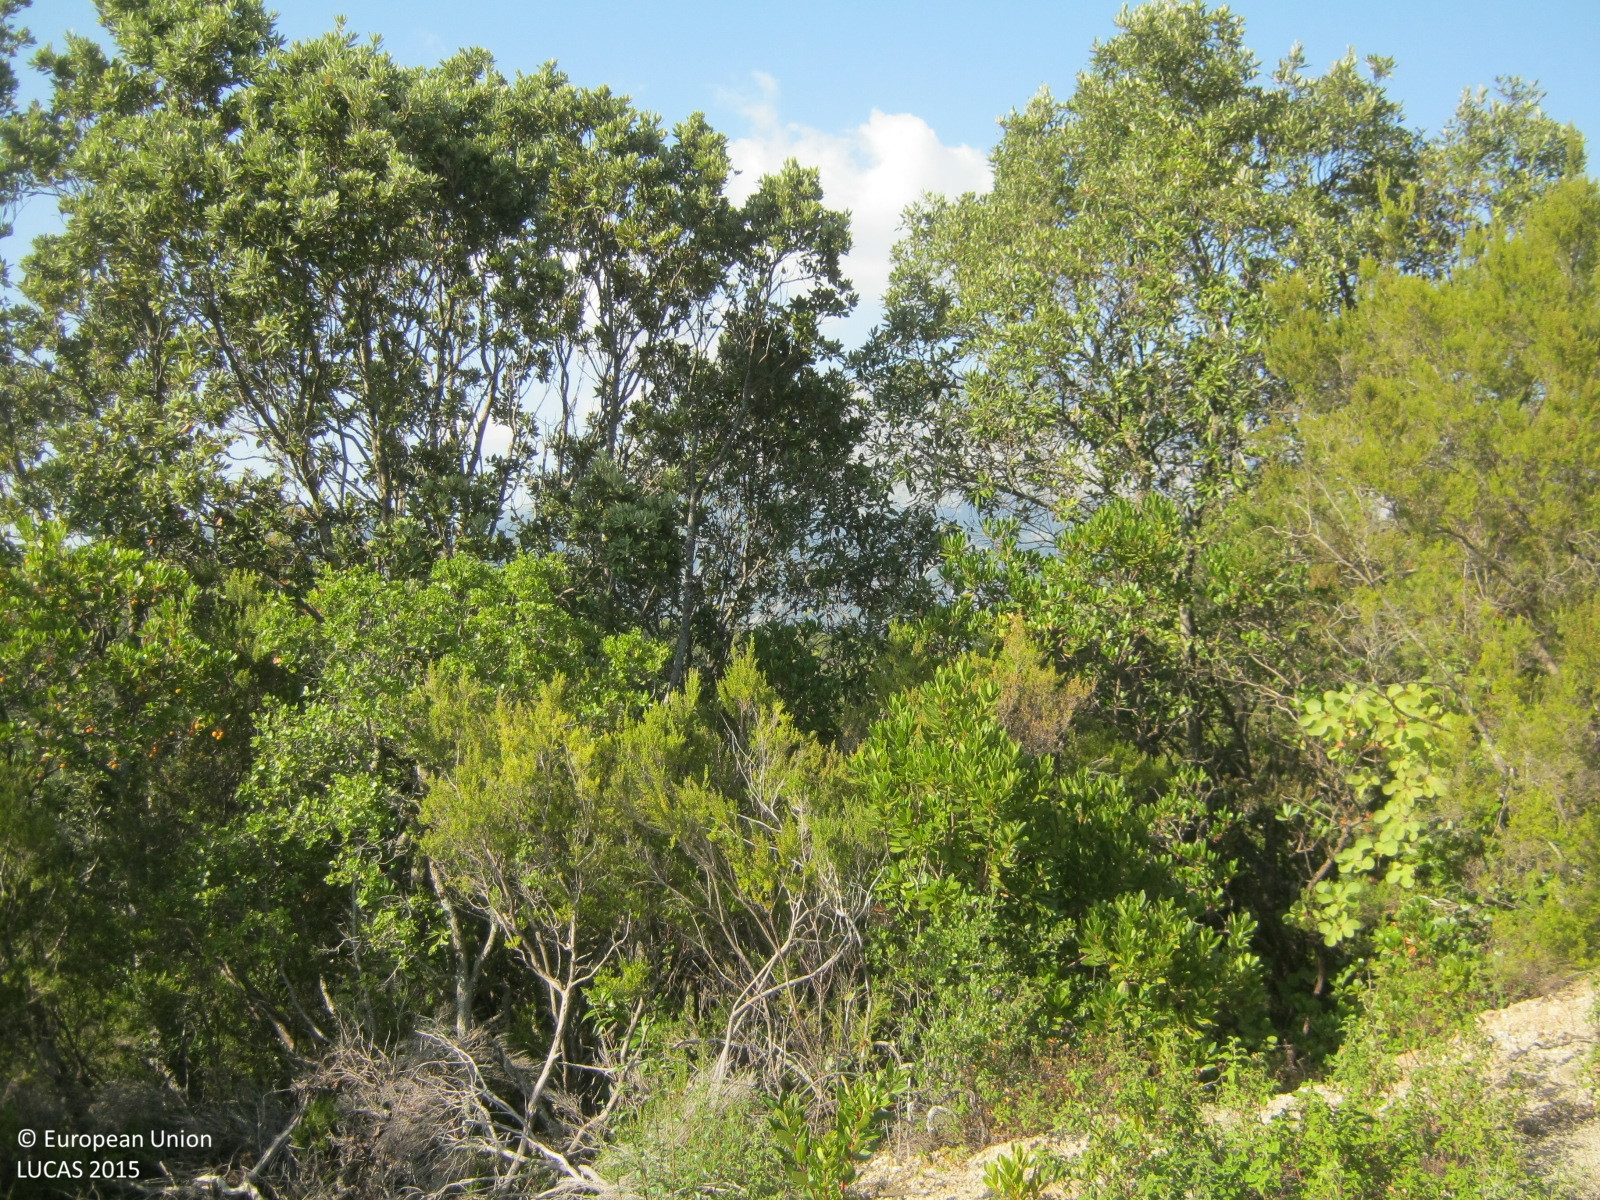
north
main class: Woodland
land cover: Broadleaved woodland
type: broadleaved evergreen forest
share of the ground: 50 - 75 %
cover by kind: broadleaved forest trees 50 %, shrubs 50 %
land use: Semi-natural and natural areas not in use
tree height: > 5 m
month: September
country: GR
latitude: 39.3198
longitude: 21.1463
